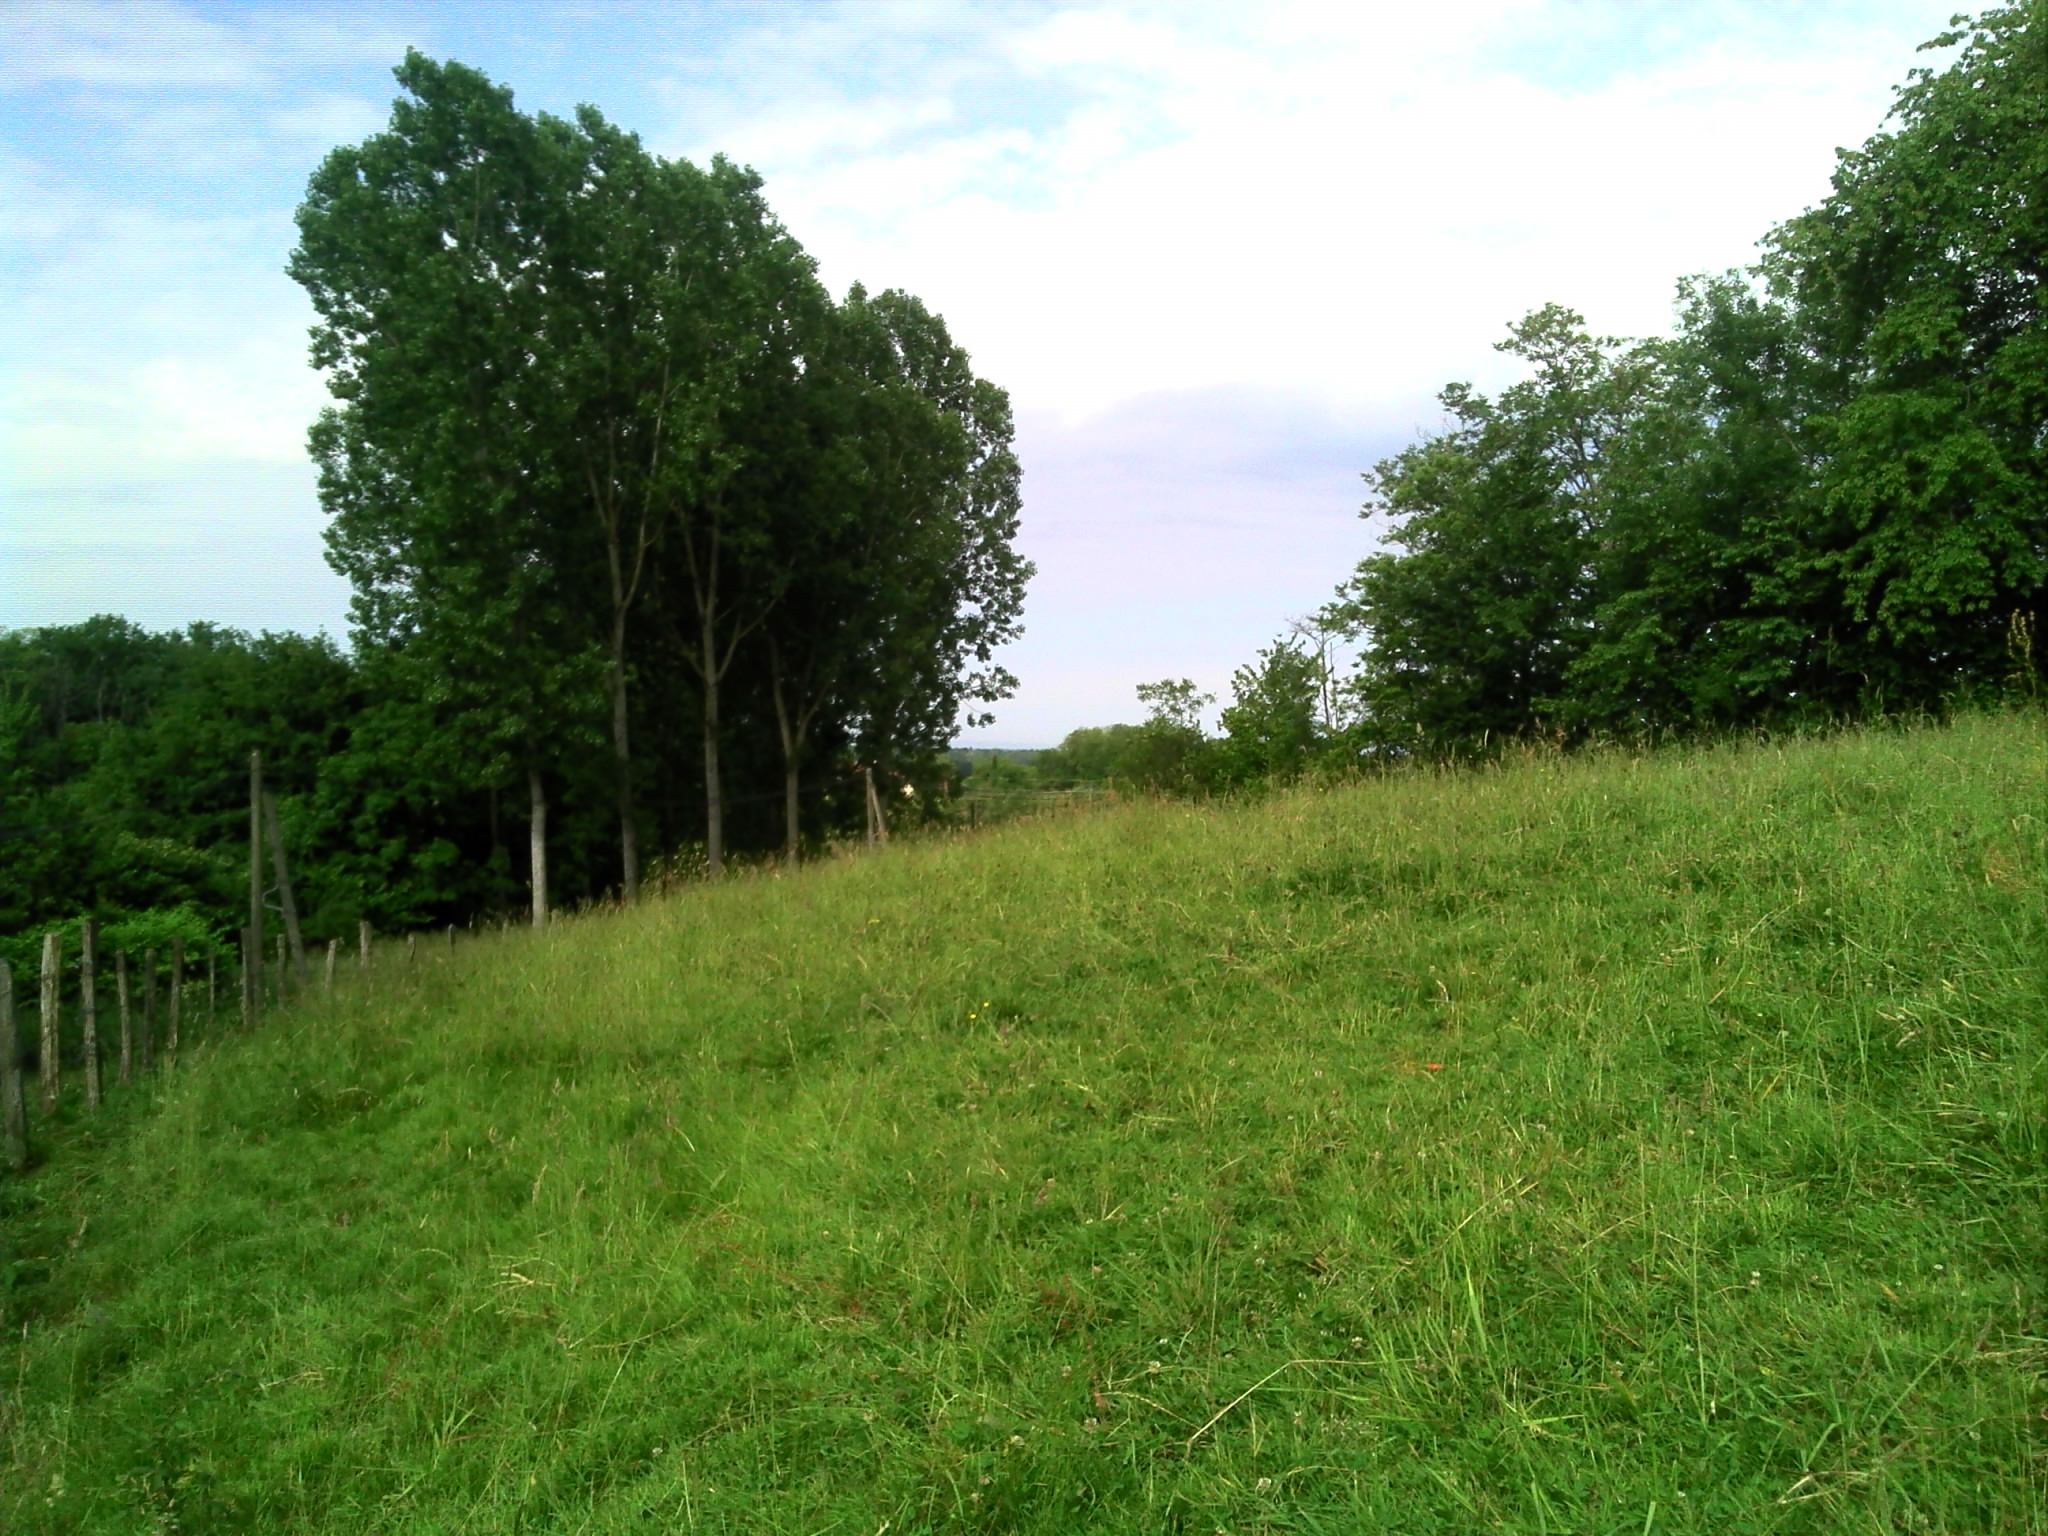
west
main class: Grassland
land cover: Grassland without tree/shrub cover
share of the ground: > 75 %
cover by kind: herbaceous plants 100 %
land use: Agriculture (excluding fallow land and kitchen gardens)
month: May
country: FR
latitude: 46.4668
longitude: 5.3536
